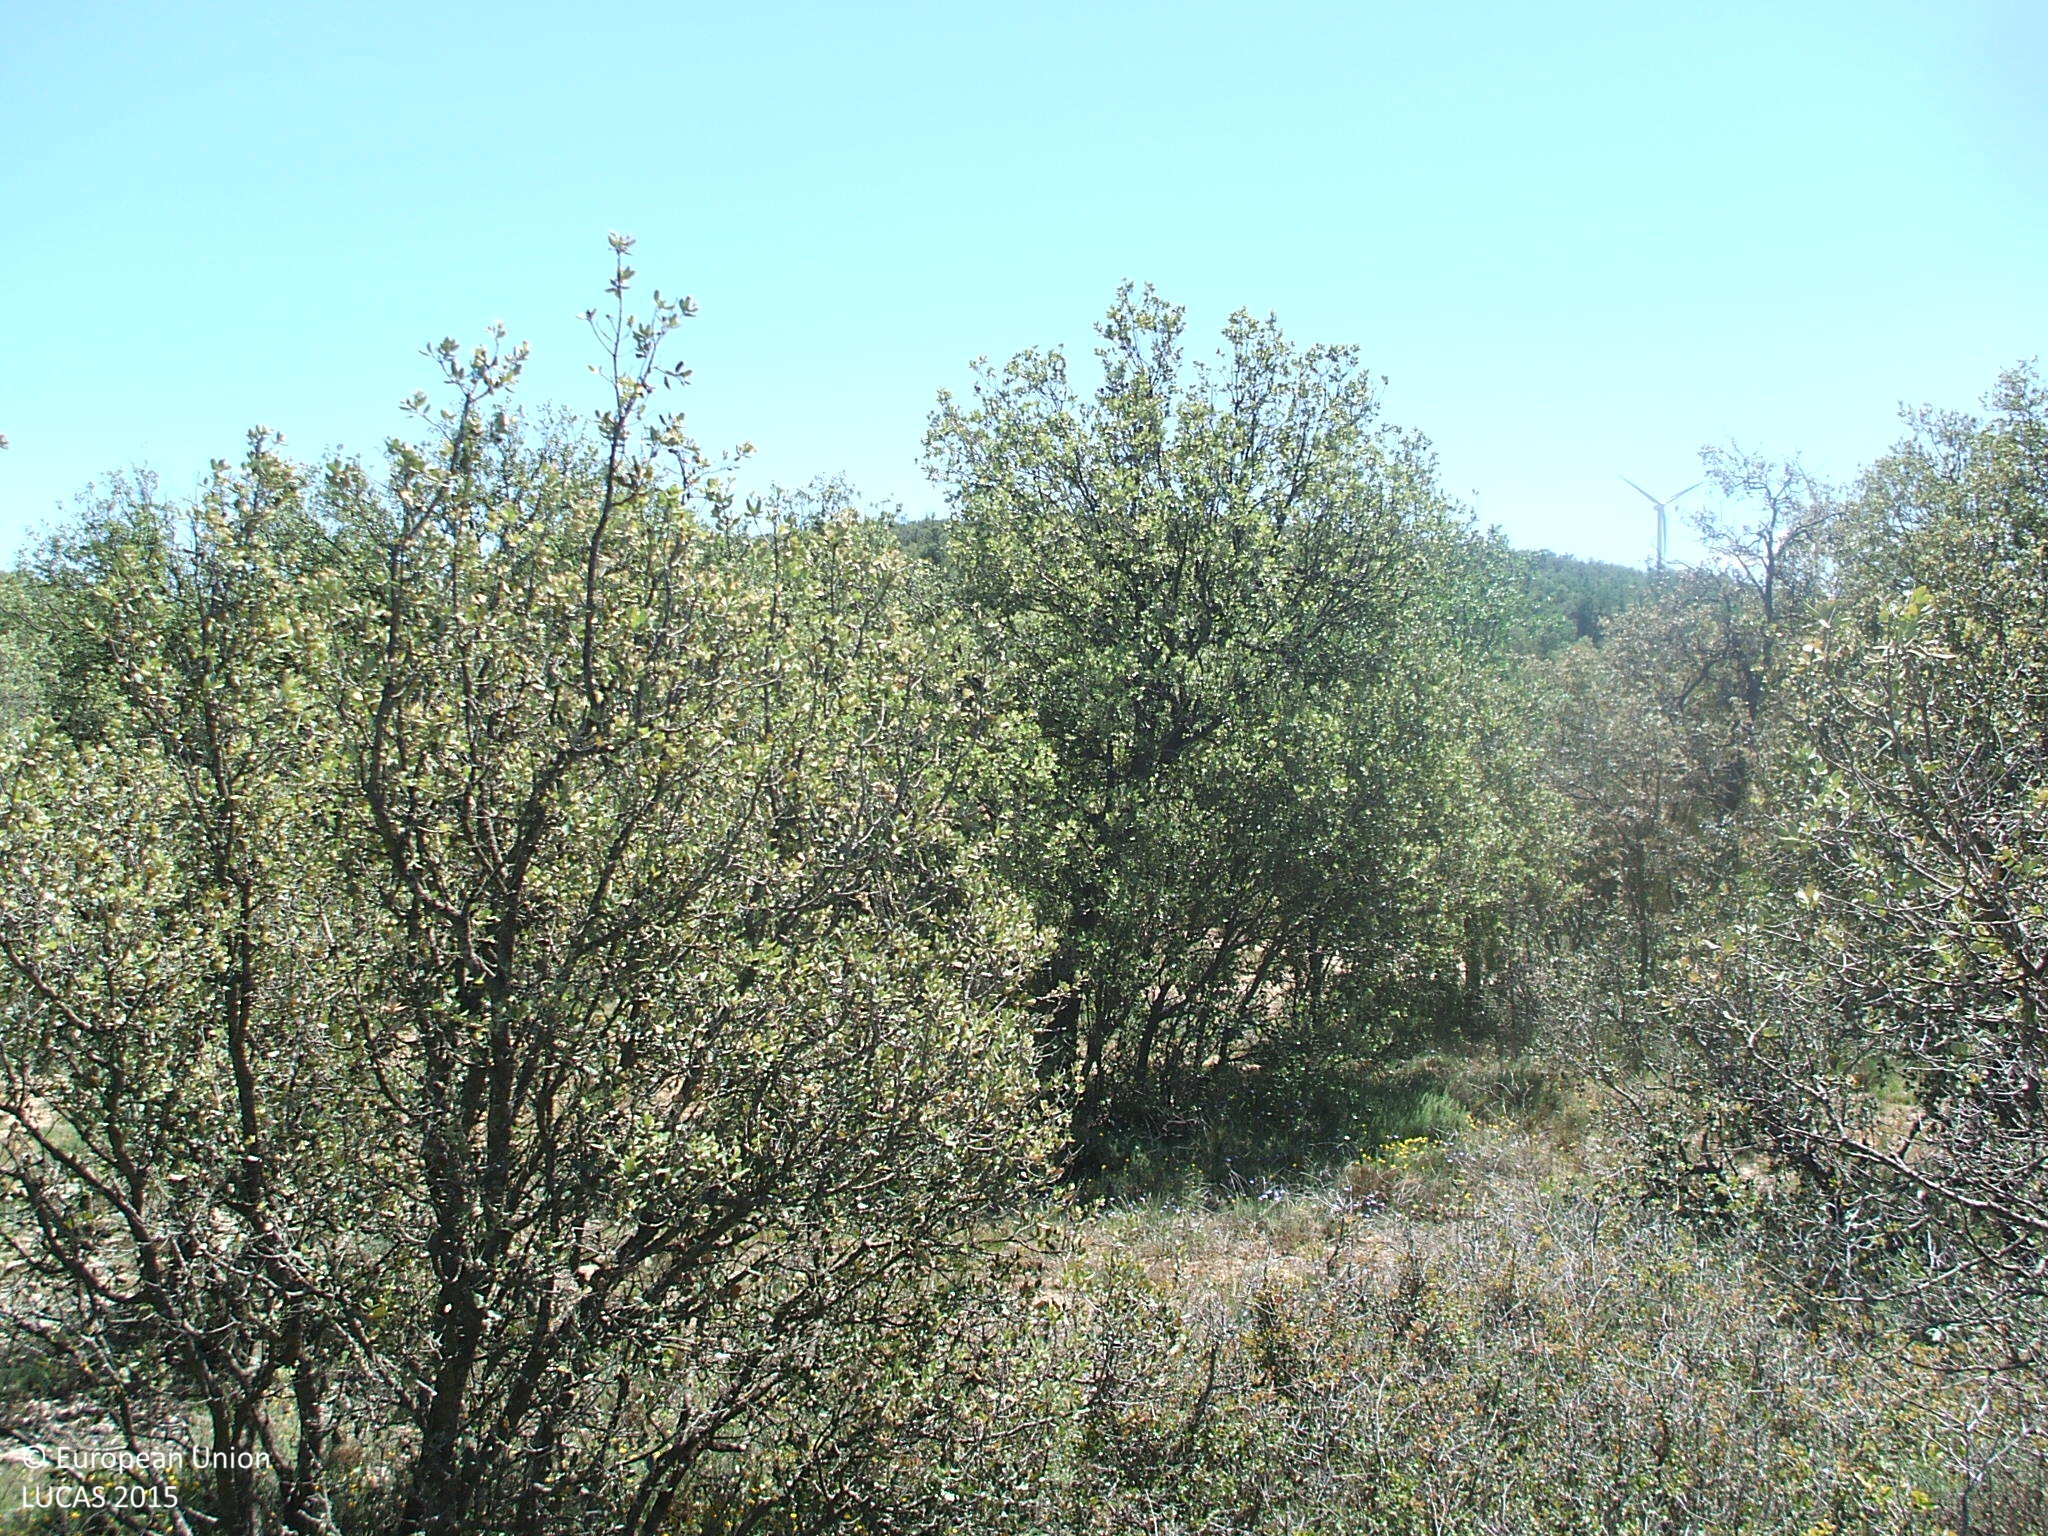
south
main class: Woodland
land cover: Broadleaved woodland
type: broadleaved evergreen forest
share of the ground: 50 - 75 %
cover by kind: broadleaved forest trees 70 %, shrubs 30 %
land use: Semi-natural and natural areas not in use
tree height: < 5 m
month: May
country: ES
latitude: 40.0061
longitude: -0.7233
